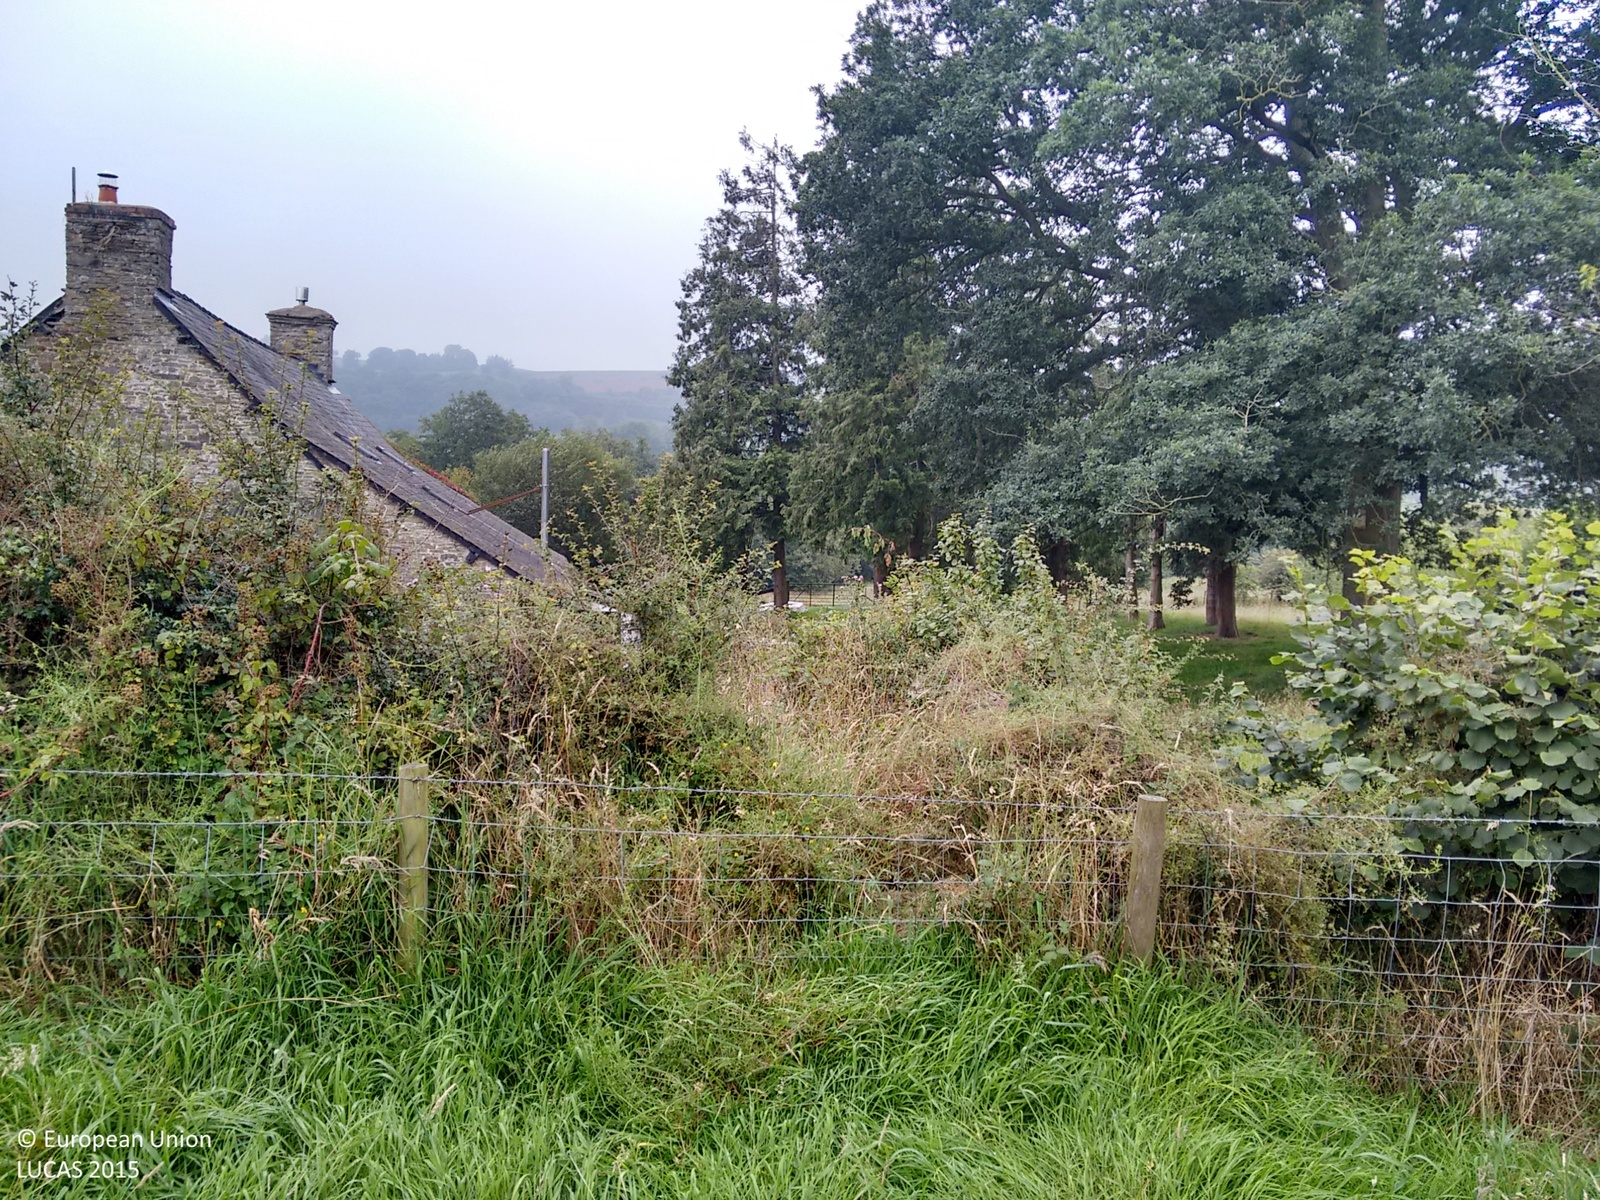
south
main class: Grassland
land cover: Grassland with sparse tree/shrub cover
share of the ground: > 75 %
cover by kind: herbaceous plants 95 %, coniferous forest trees 5 %
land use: Agriculture (excluding fallow land and kitchen gardens)
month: September
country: GB
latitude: 52.1062
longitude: -3.2344
